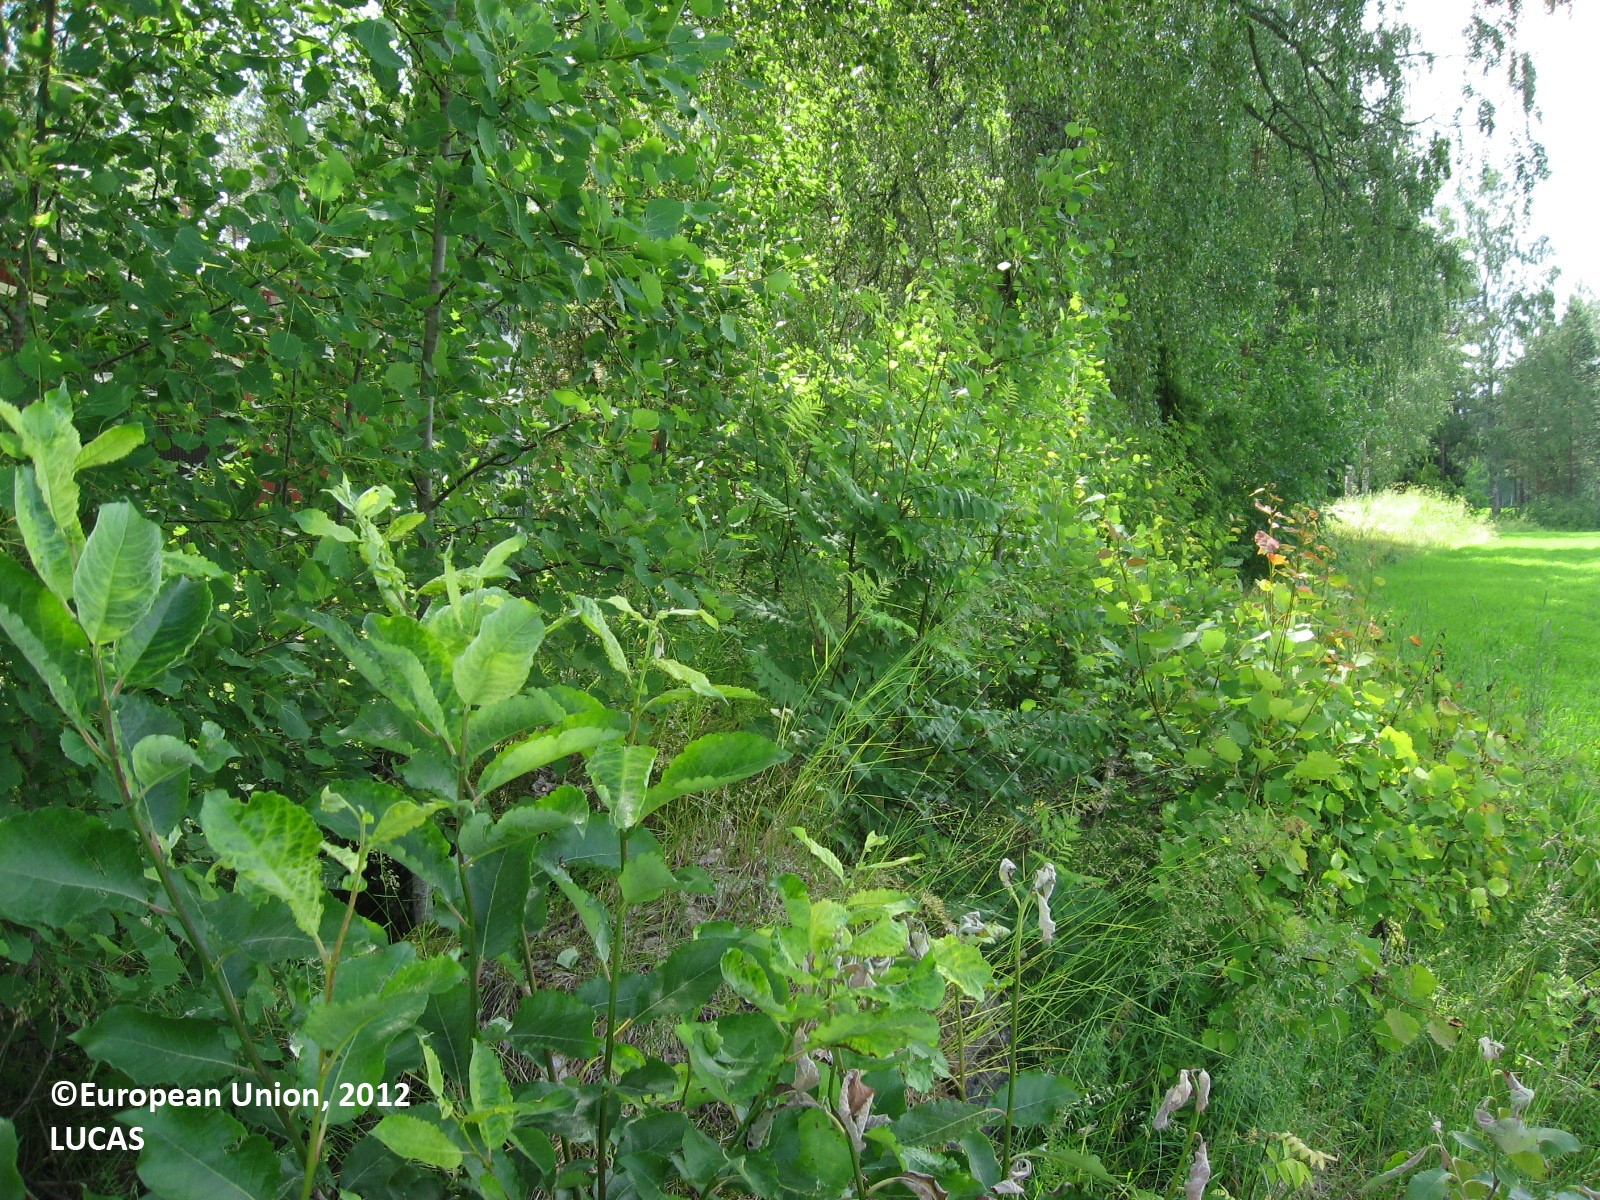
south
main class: Cropland
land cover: Barley
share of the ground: > 75 %
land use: Agriculture (excluding fallow land and kitchen gardens)
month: July
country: FI
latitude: 60.9275
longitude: 26.5551
